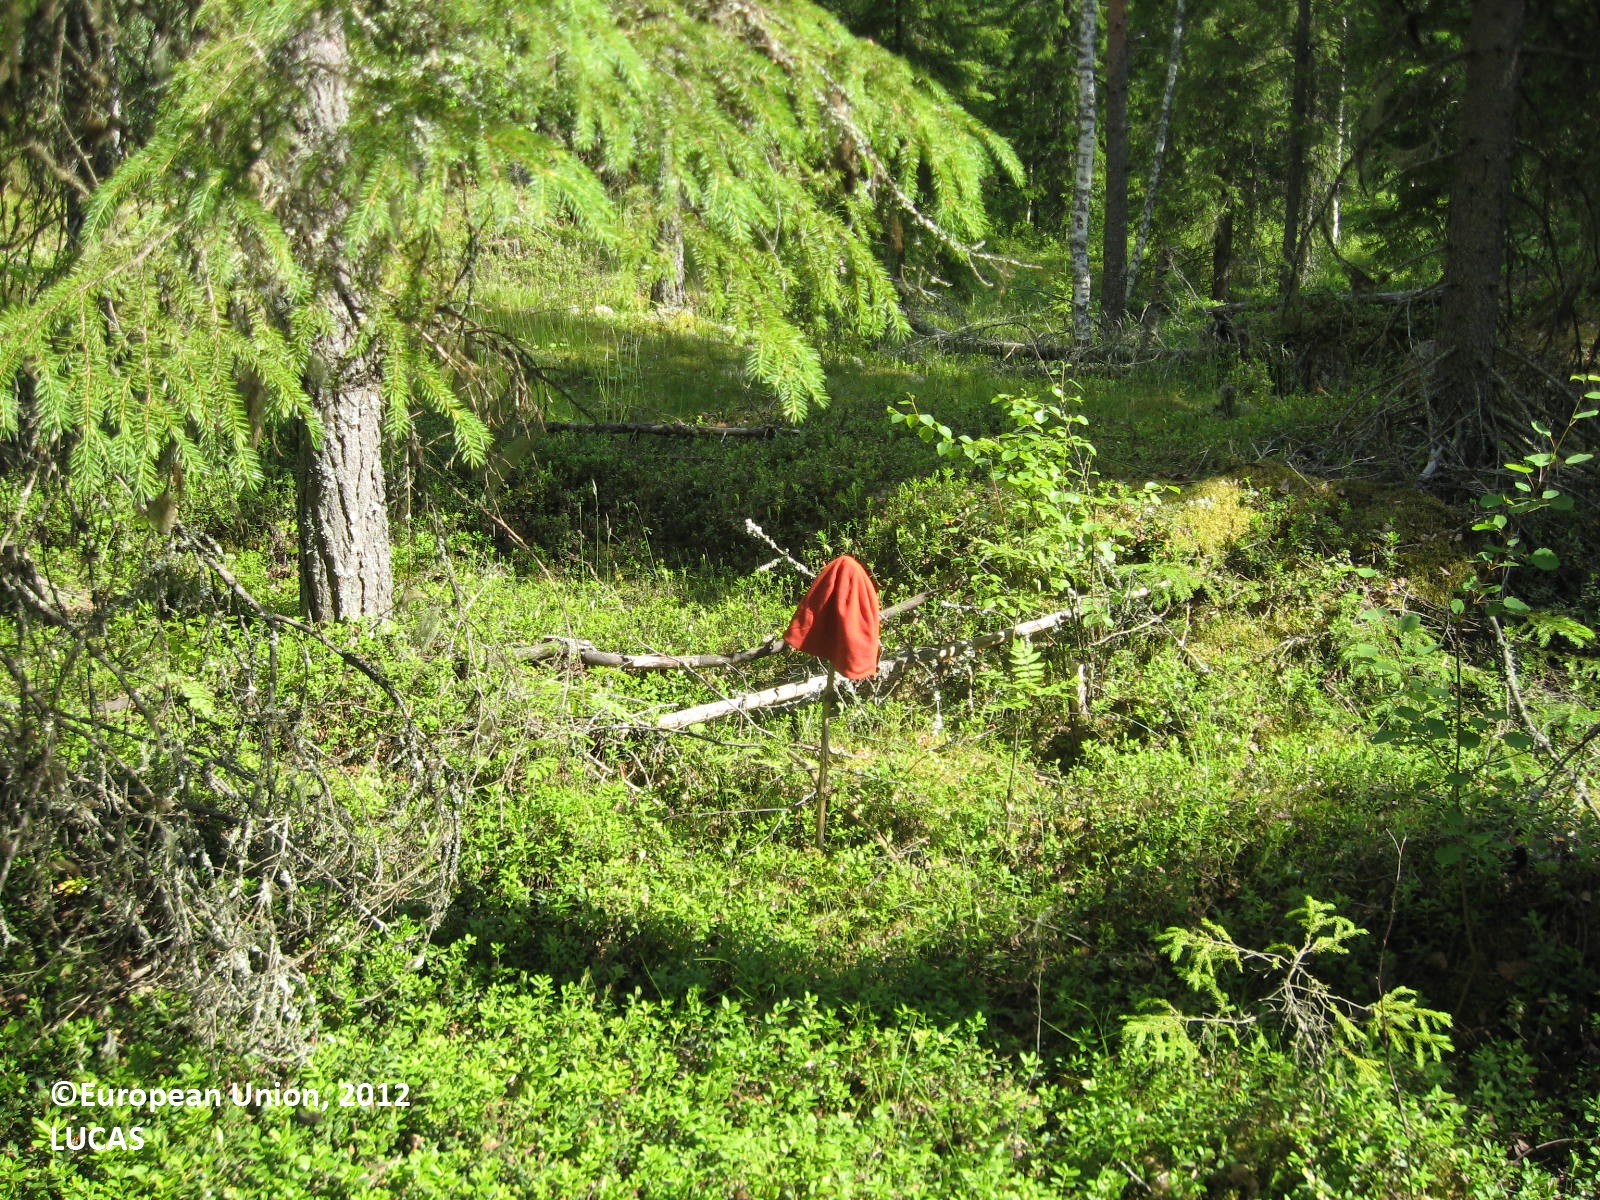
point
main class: Woodland
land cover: Spruce dominated mixed woodland
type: boreal forest
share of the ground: 50 - 75 %
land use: Forestry
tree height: > 5 m
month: July
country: FI
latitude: 62.6270
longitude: 22.6311
